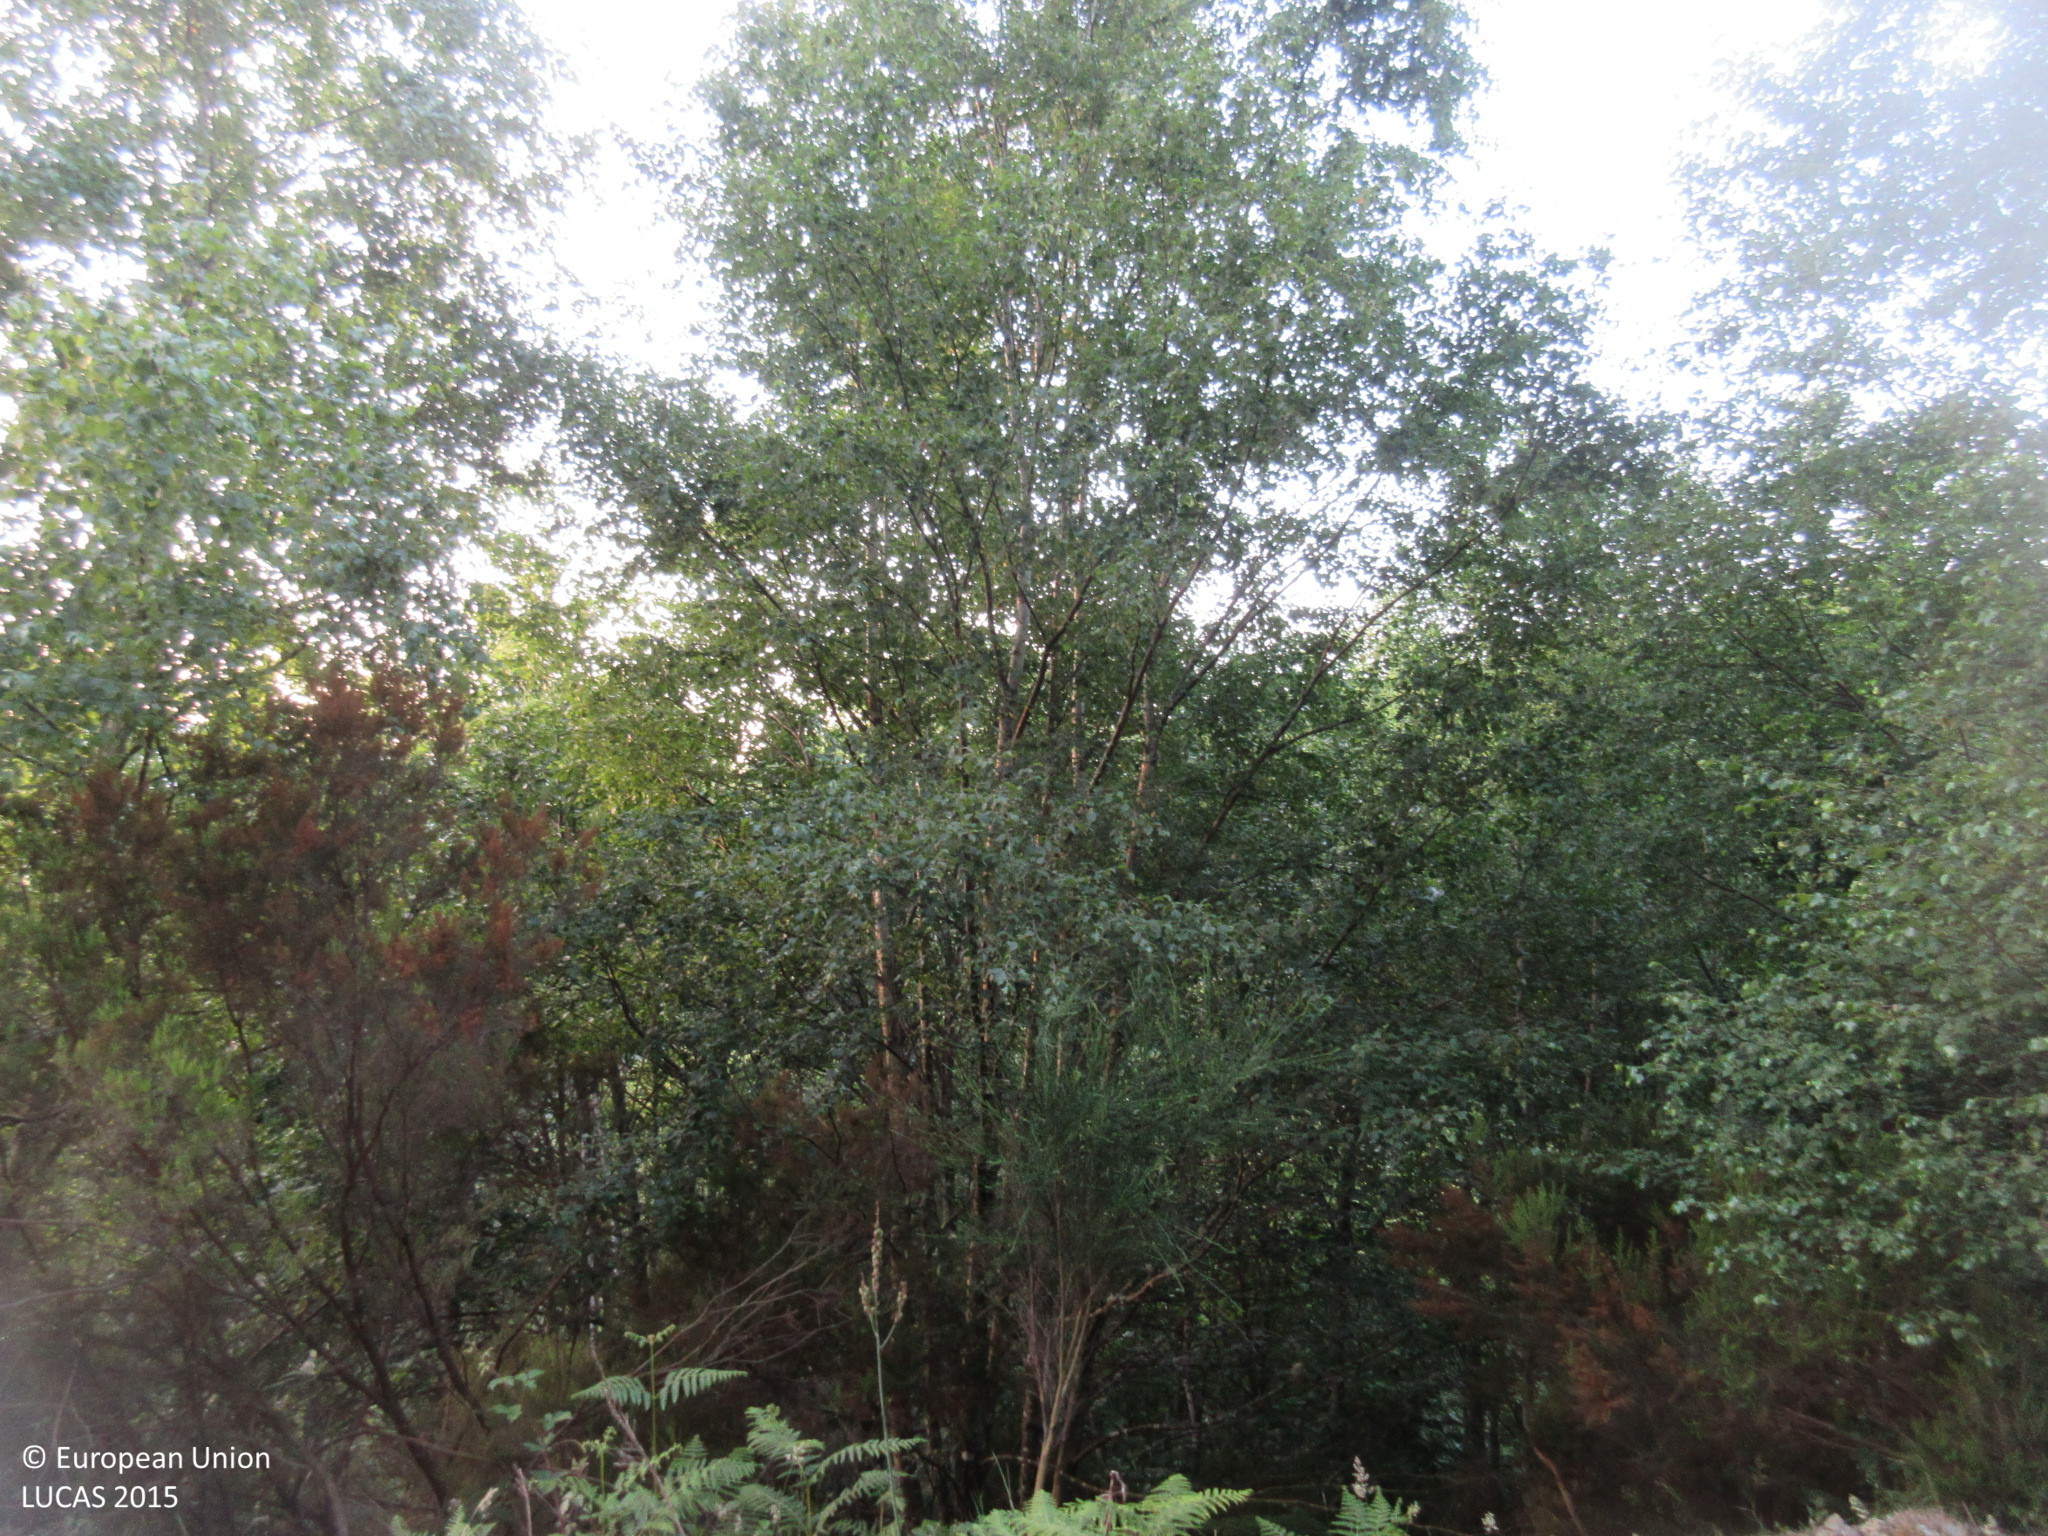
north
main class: Woodland
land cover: Pine dominated coniferous woodland
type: hemiboreal forest and nemoral coniferous forest and mixed broadleaved-coniferous forest
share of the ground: > 75 %
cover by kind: coniferous forest trees 90 %, shrubs 10 %
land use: Forestry
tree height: > 5 m
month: June
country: ES
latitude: 43.0525
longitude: -7.0684
